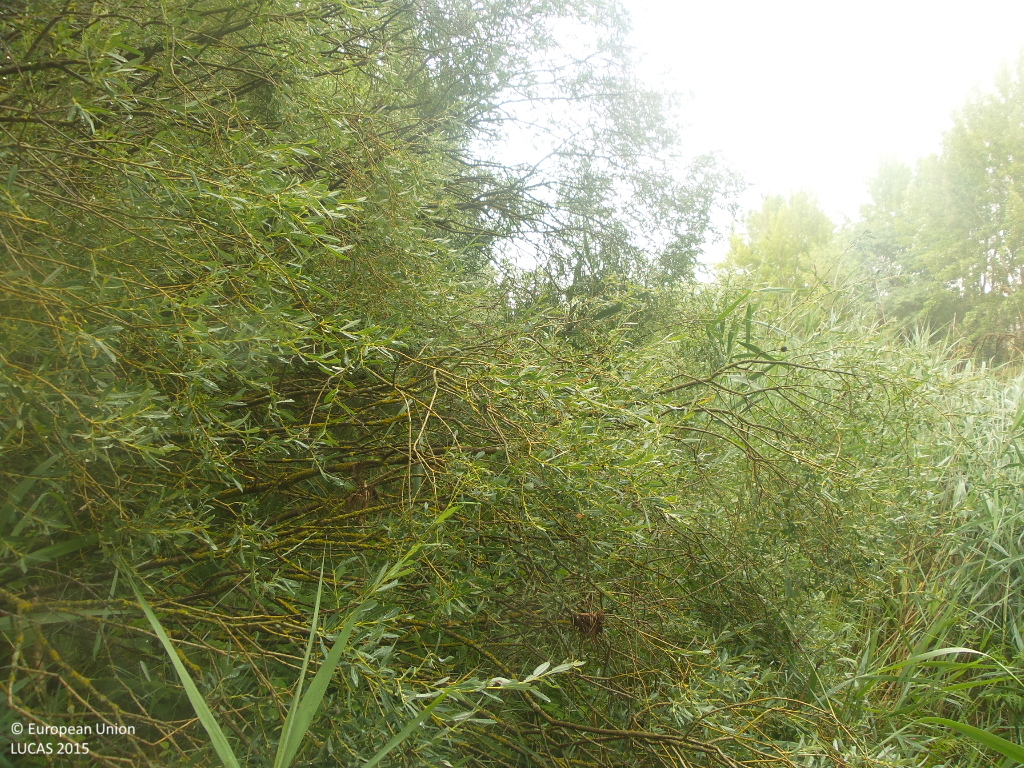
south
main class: Woodland
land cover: Broadleaved woodland
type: floodplain forest
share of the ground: > 75 %
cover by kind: broadleaved forest trees 80 %, shrubs 10 %, herbaceous plants 10 %
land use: Semi-natural and natural areas not in use
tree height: > 5 m
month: June
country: ES
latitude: 41.4978
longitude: -2.7482
